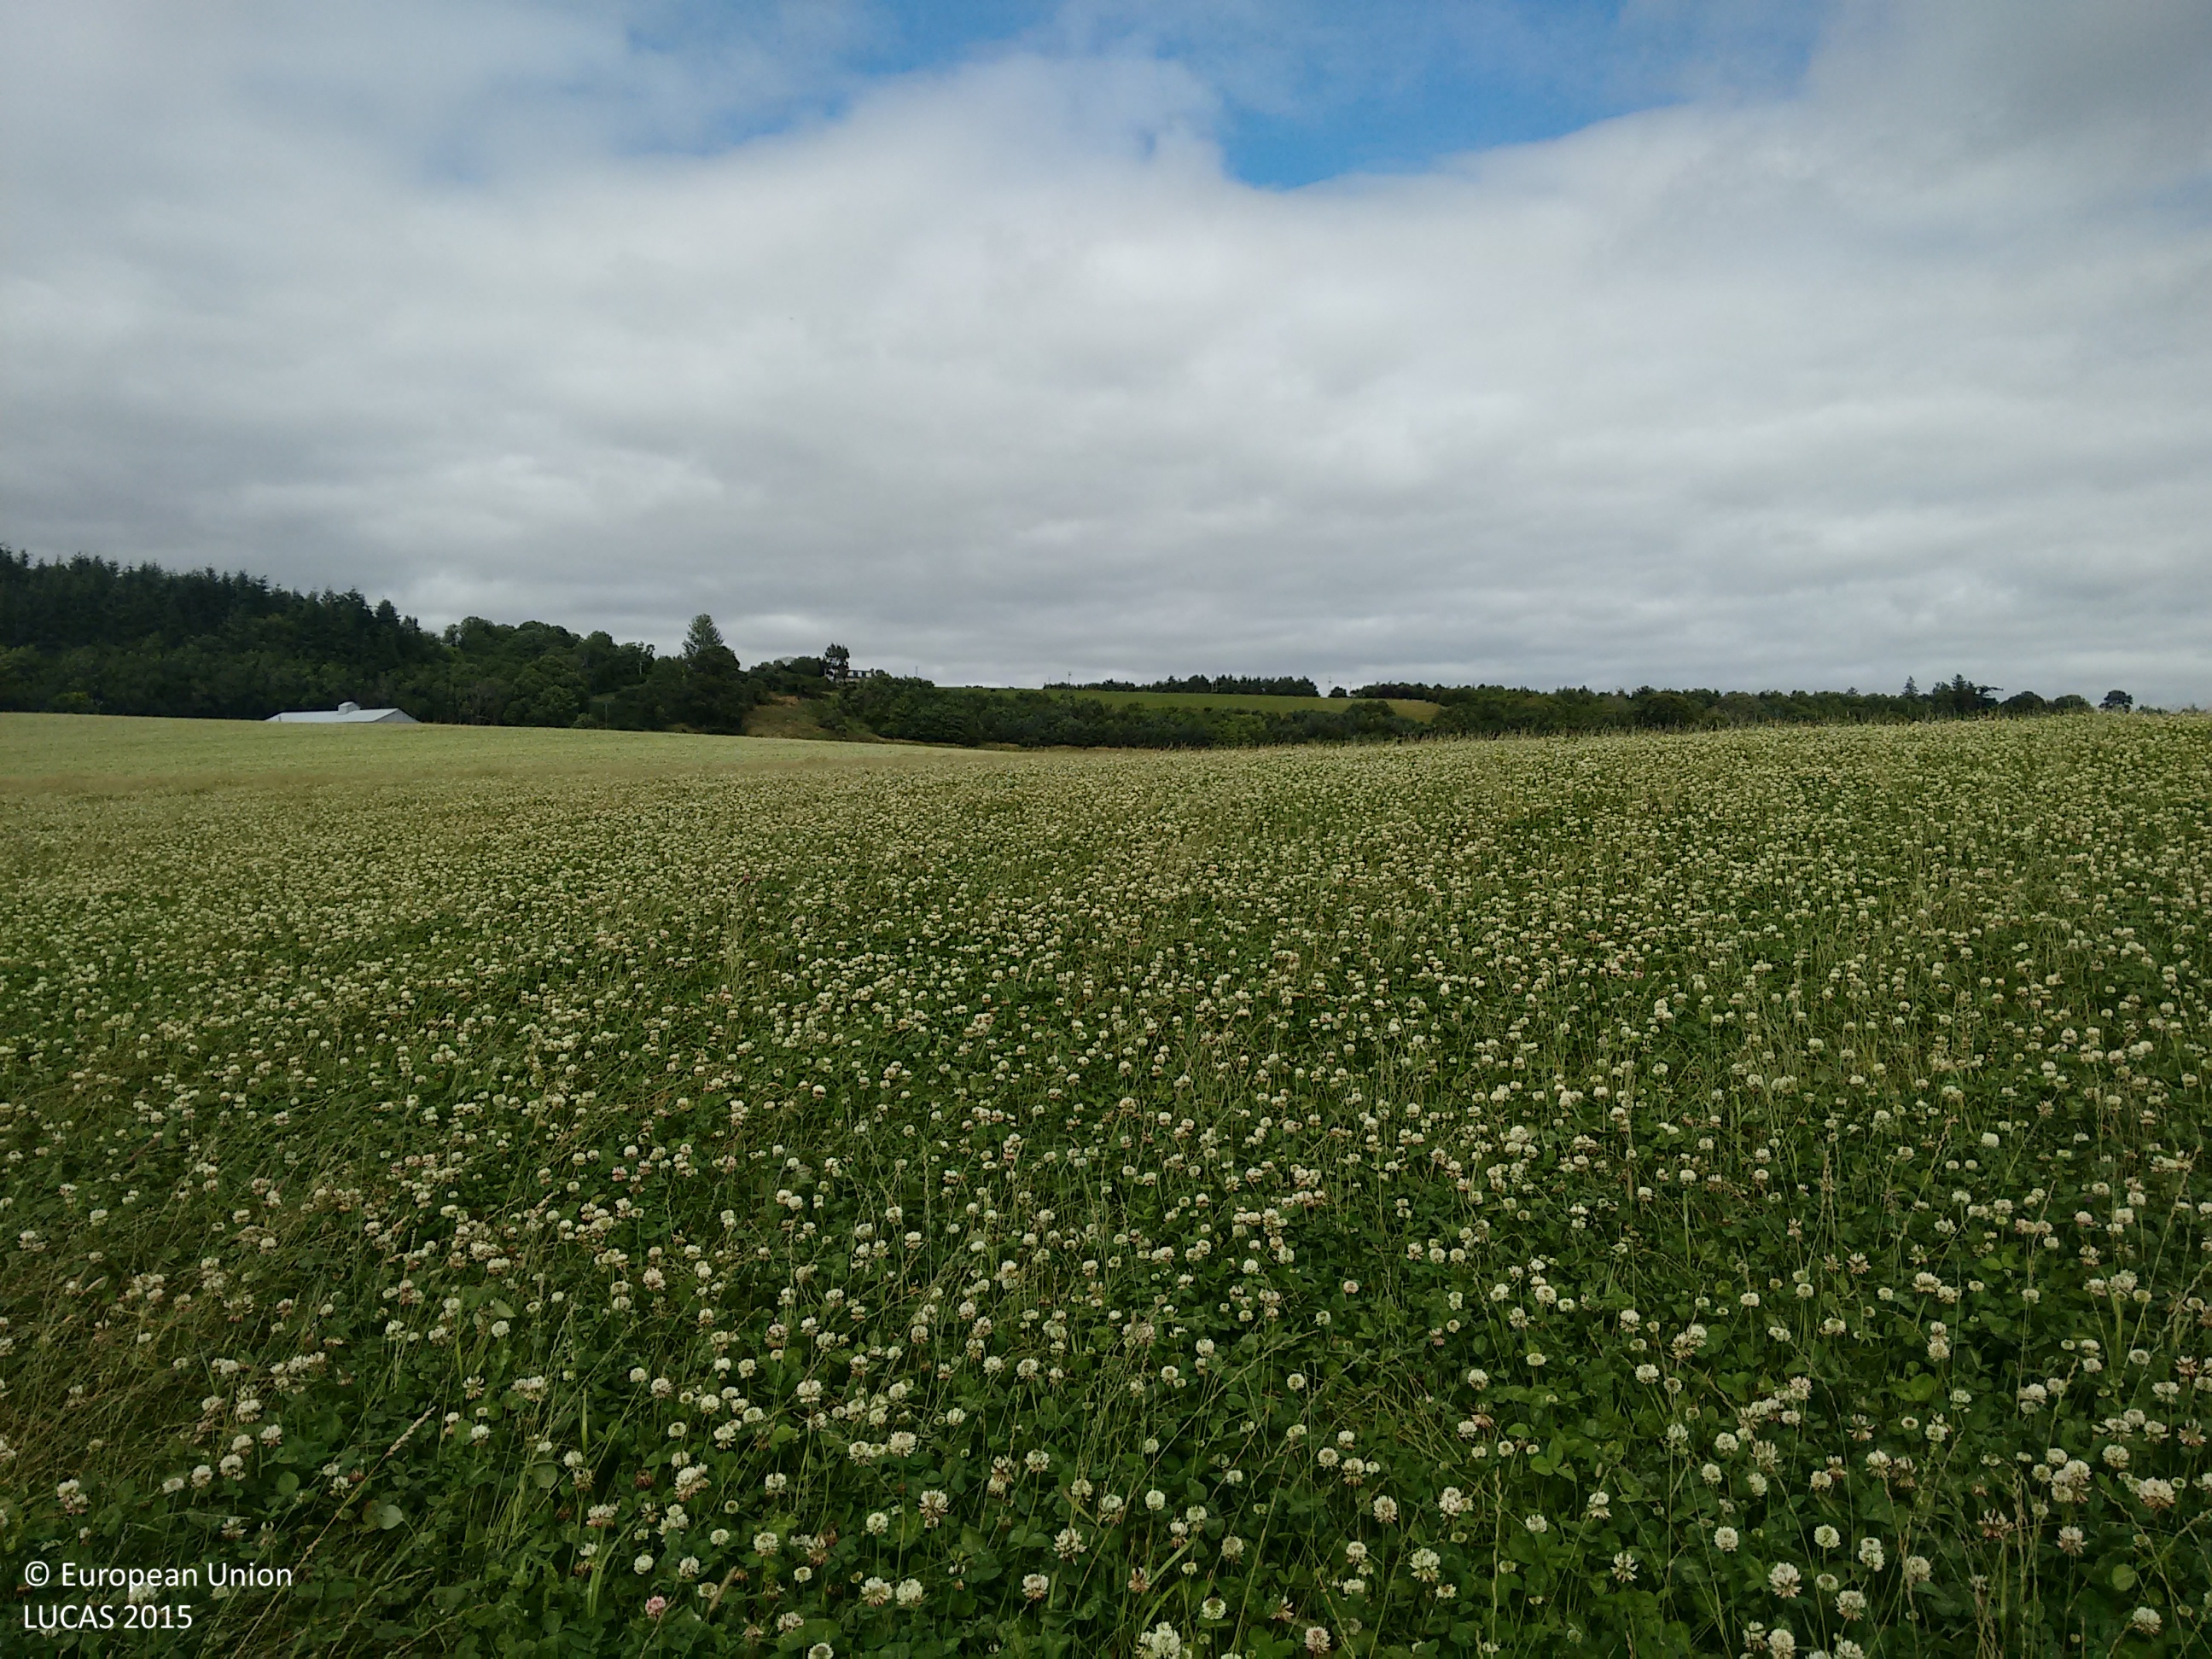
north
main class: Cropland
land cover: Clovers
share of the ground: > 75 %
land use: Agriculture (excluding fallow land and kitchen gardens)
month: August
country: GB
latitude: 57.5053
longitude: -4.2892
